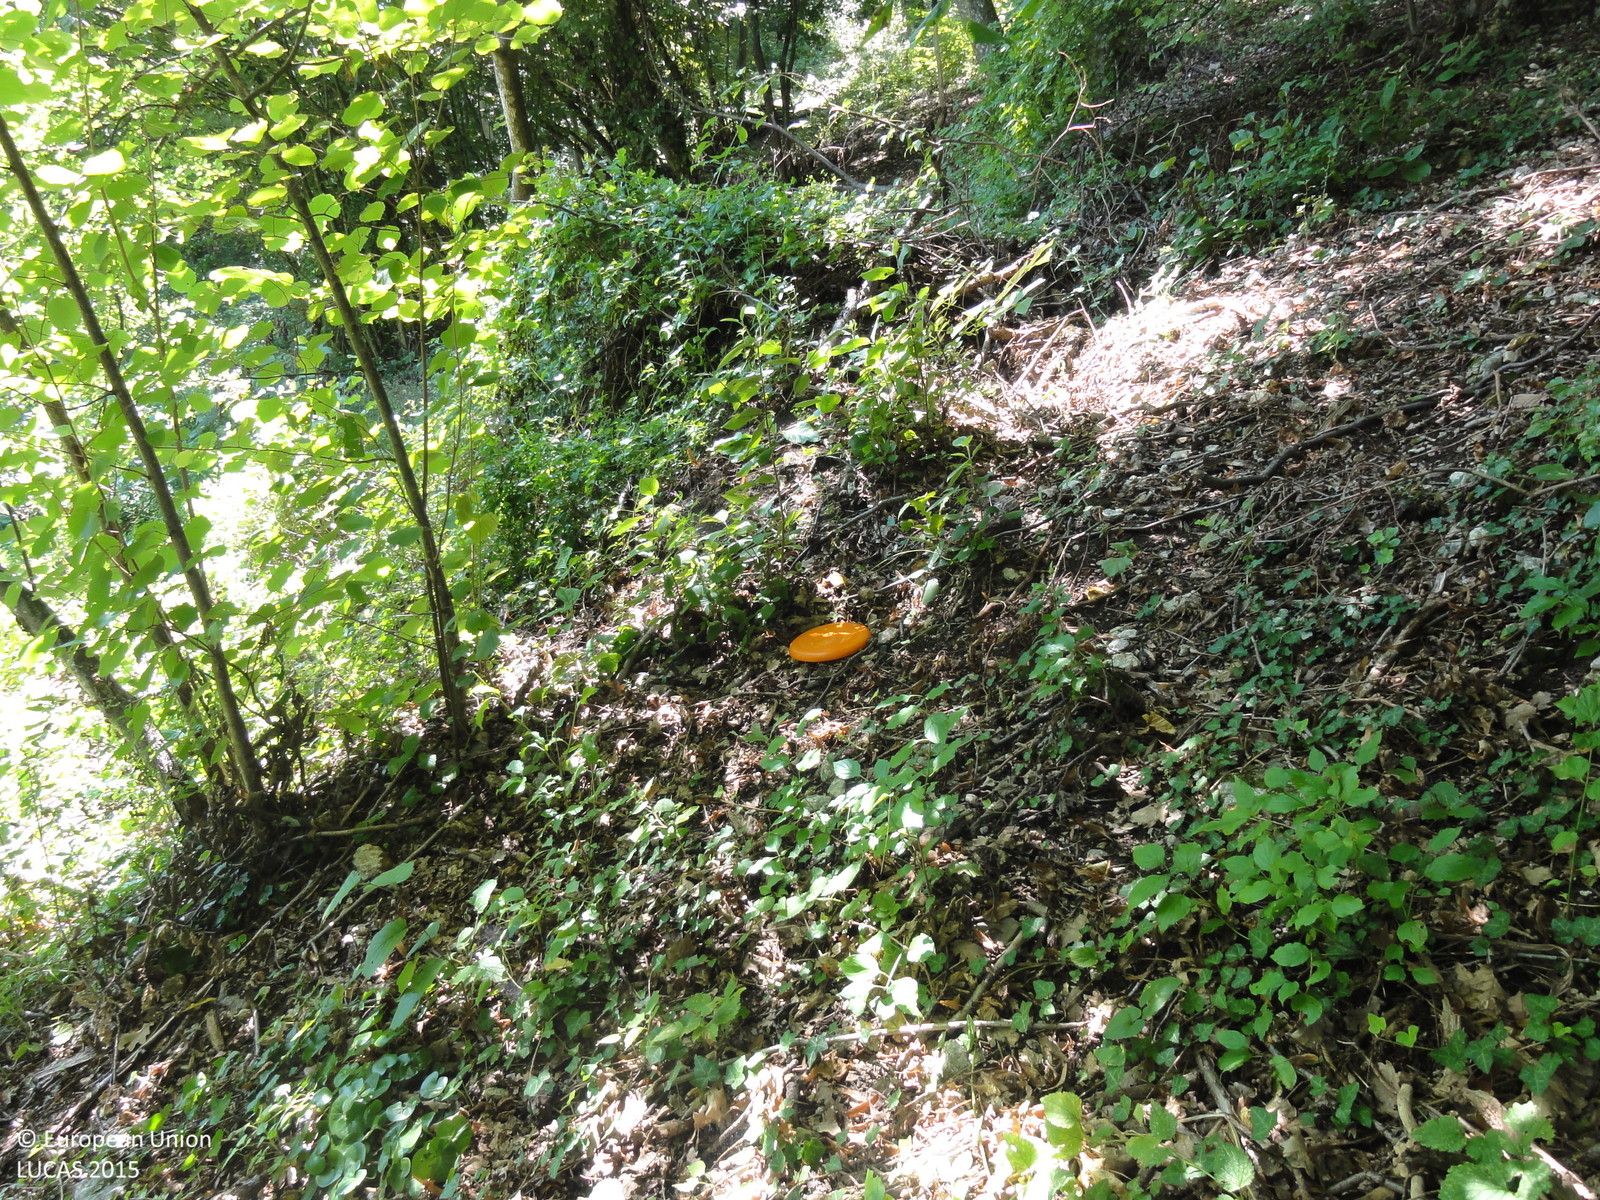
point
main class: Woodland
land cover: Broadleaved woodland
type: mesophytic deciduous forest
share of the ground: > 75 %
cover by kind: broadleaved forest trees 85 %, herbaceous plants 10 %, shrubs 5 %
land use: Forestry
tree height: > 5 m
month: August
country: SI
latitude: 46.0311
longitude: 15.4625
